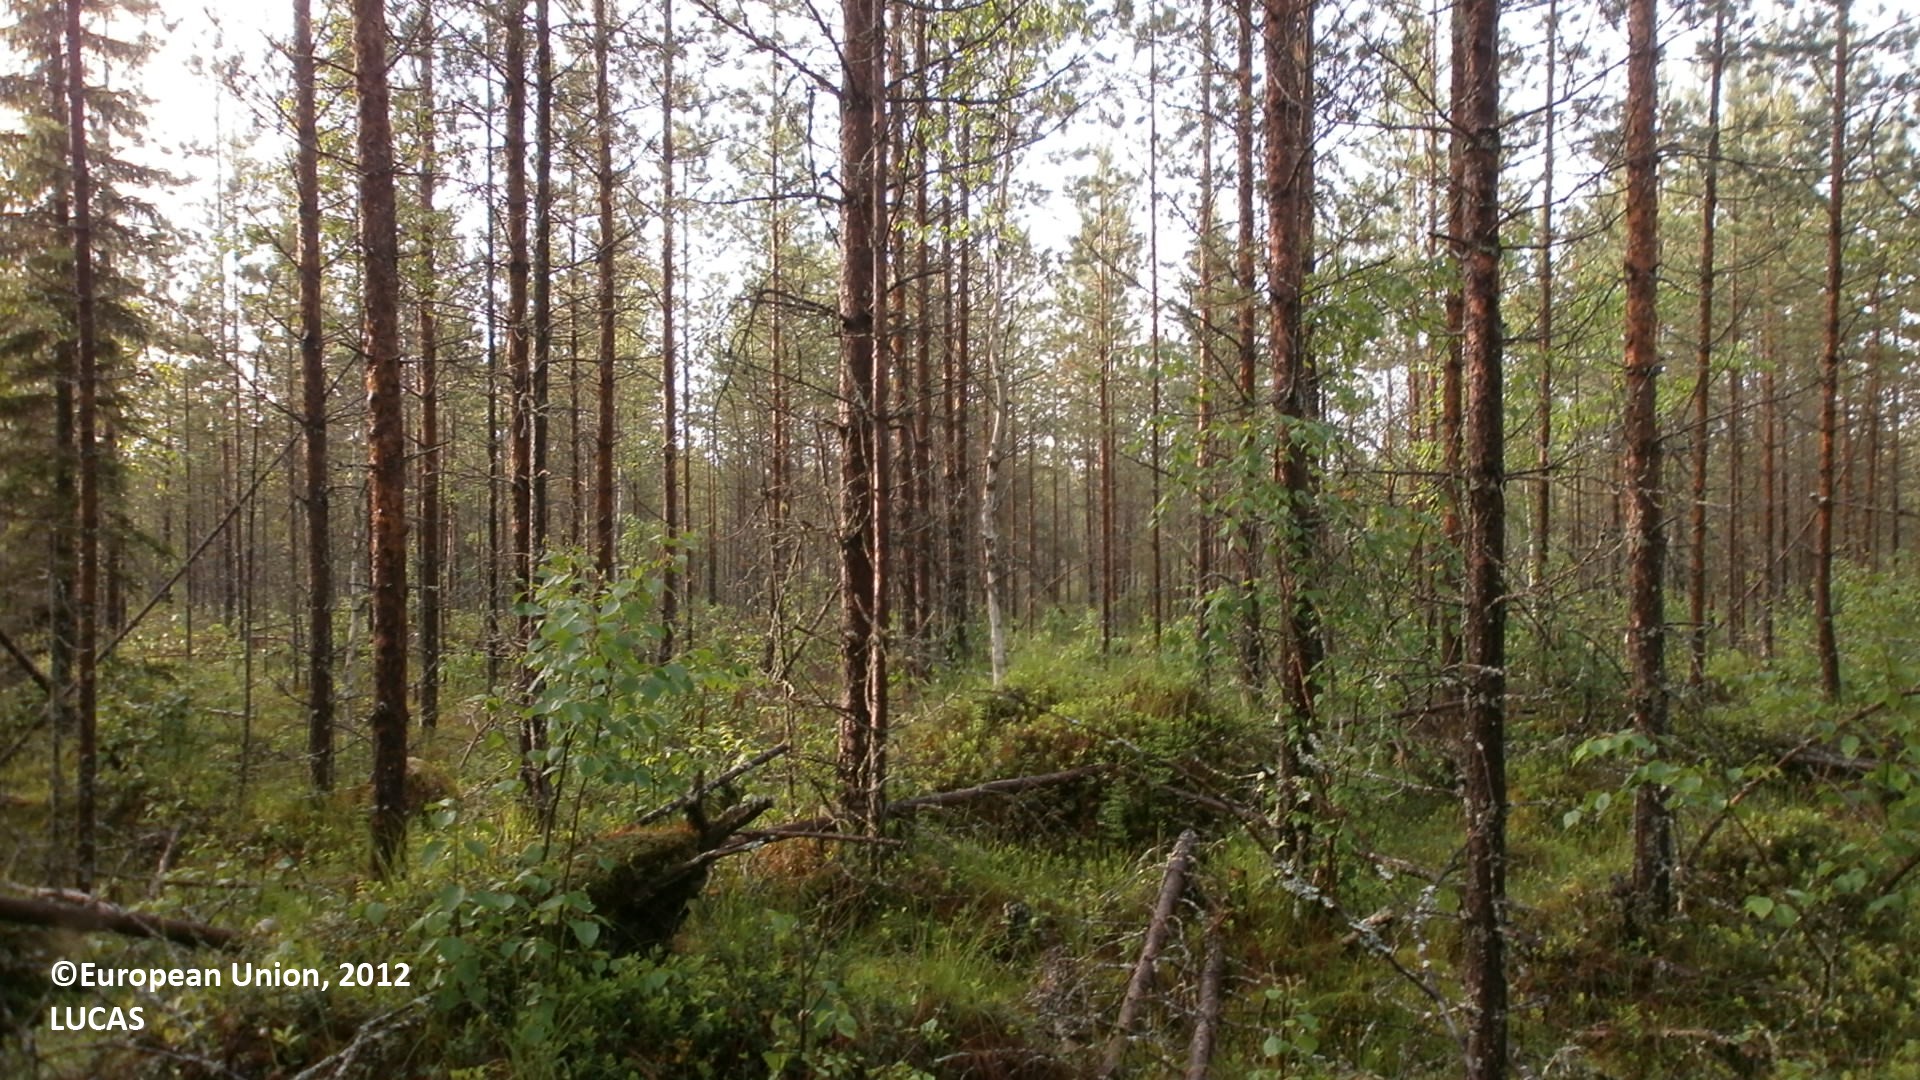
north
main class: Woodland
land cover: Pine dominated coniferous woodland
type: mire and swamp forests
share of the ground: 50 - 75 %
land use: Forestry
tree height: > 5 m
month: June
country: FI
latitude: 64.8075
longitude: 25.1758
